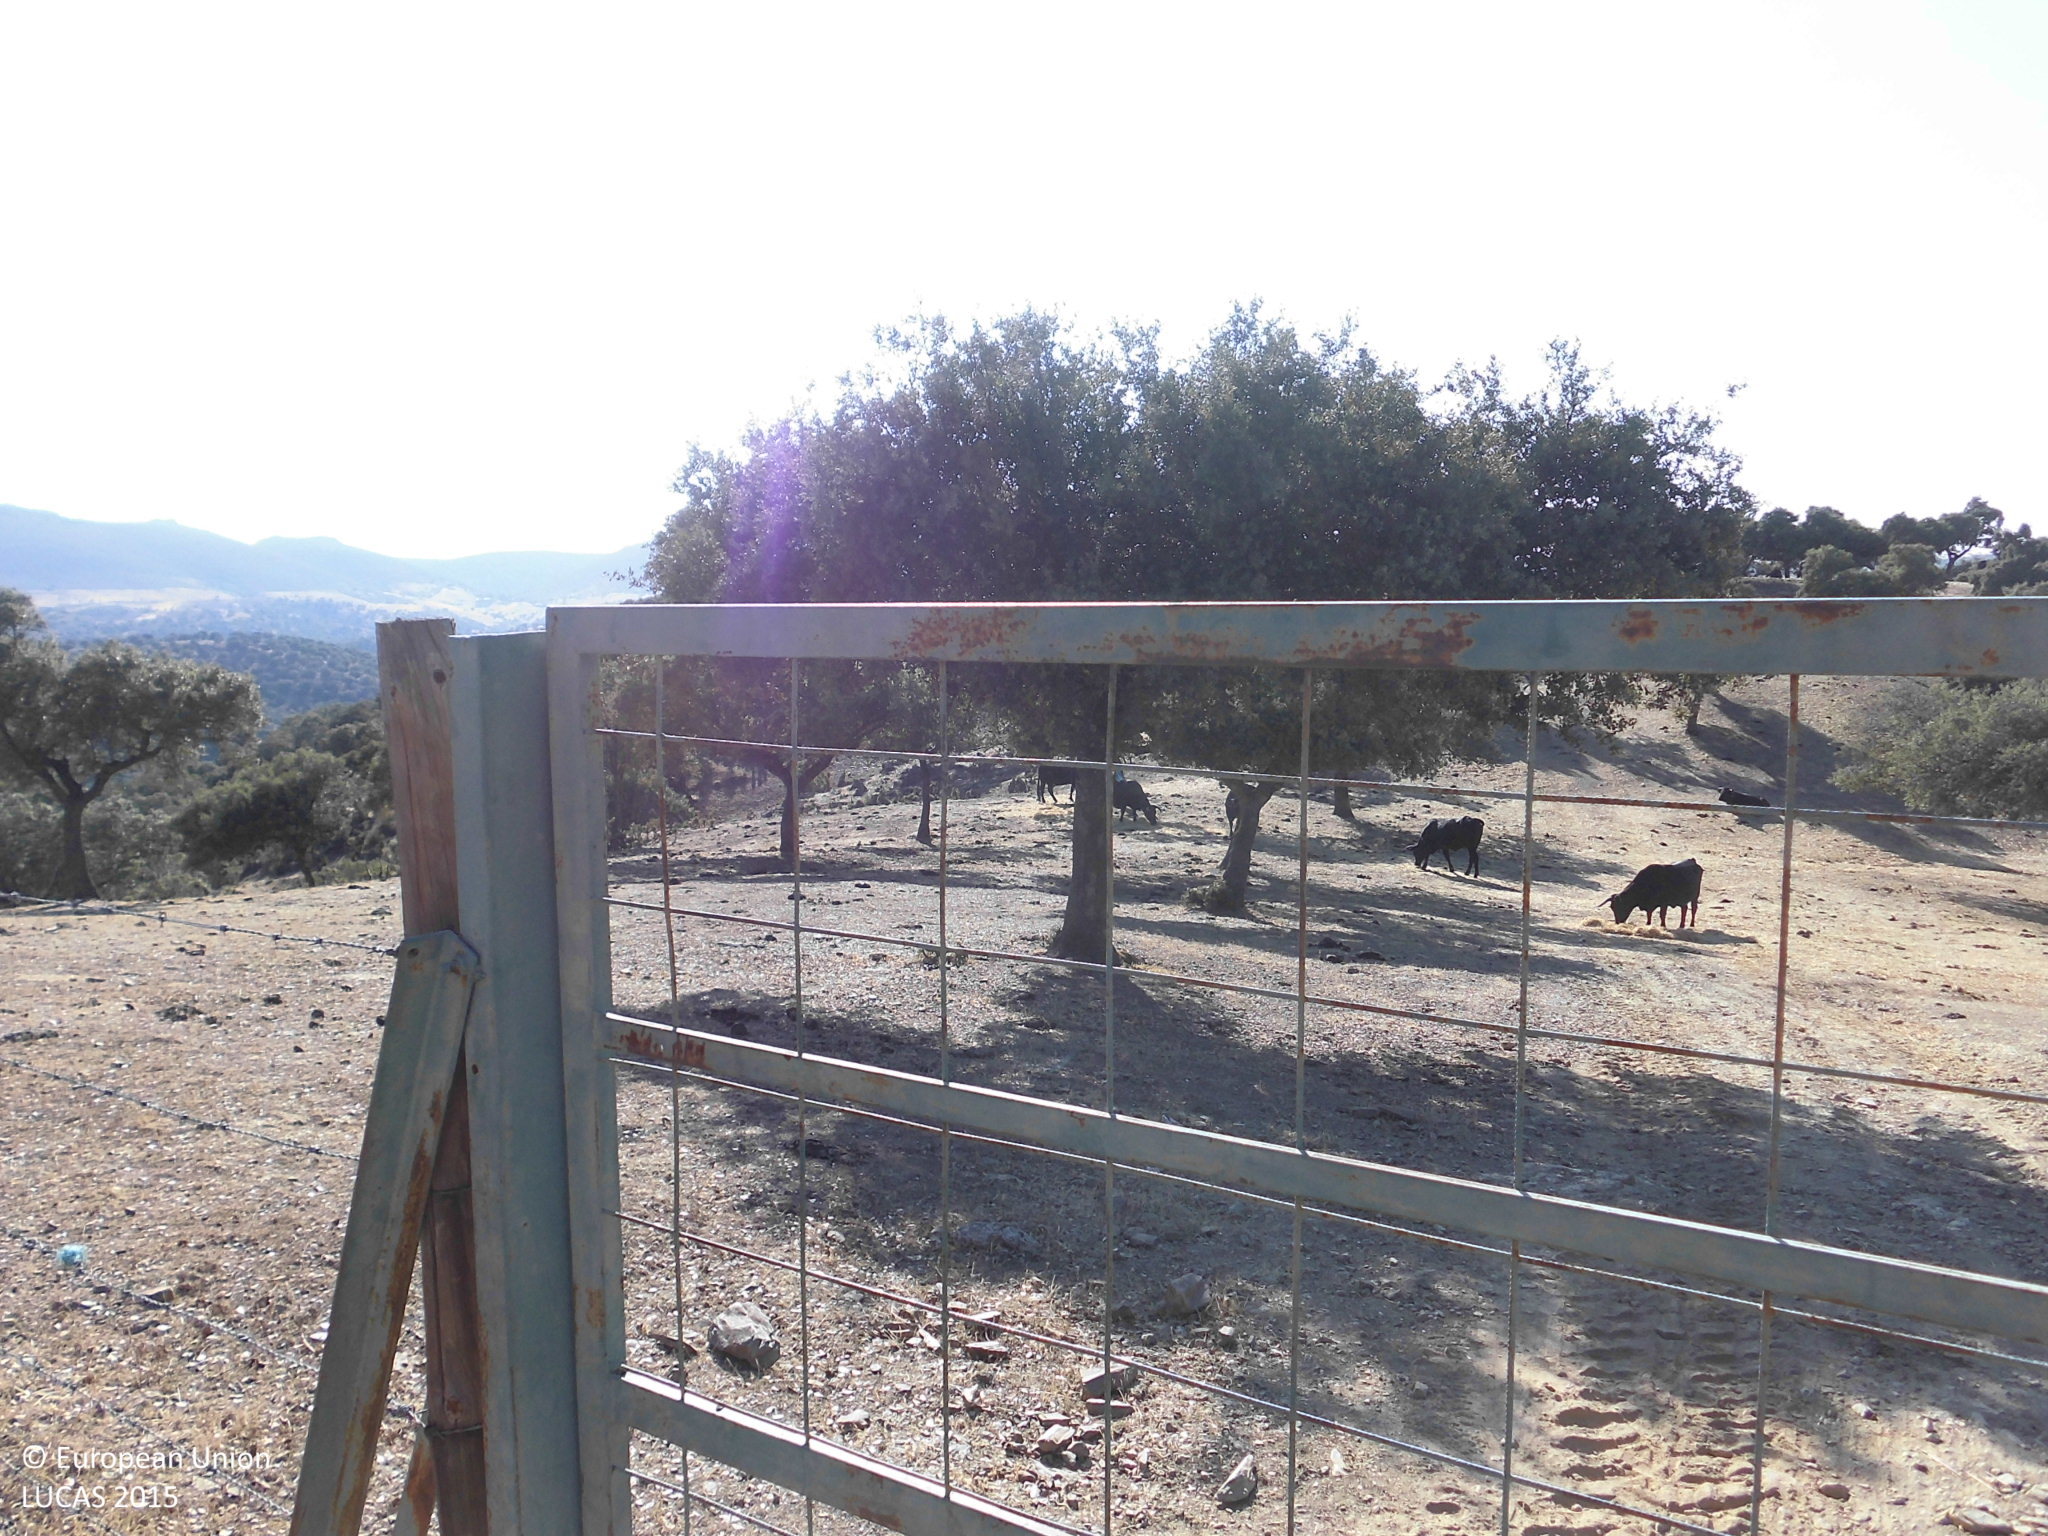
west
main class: Woodland
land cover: Broadleaved woodland
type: broadleaved evergreen forest
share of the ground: 10 - 25 %
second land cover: Grassland without tree/shrub cover
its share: > 75 %
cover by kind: herbaceous plants 80 %, broadleaved forest trees 20 %
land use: Forestry
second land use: Agriculture (excluding fallow land and kitchen gardens)
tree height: > 5 m
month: July
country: ES
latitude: 39.9461
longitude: -6.7147
